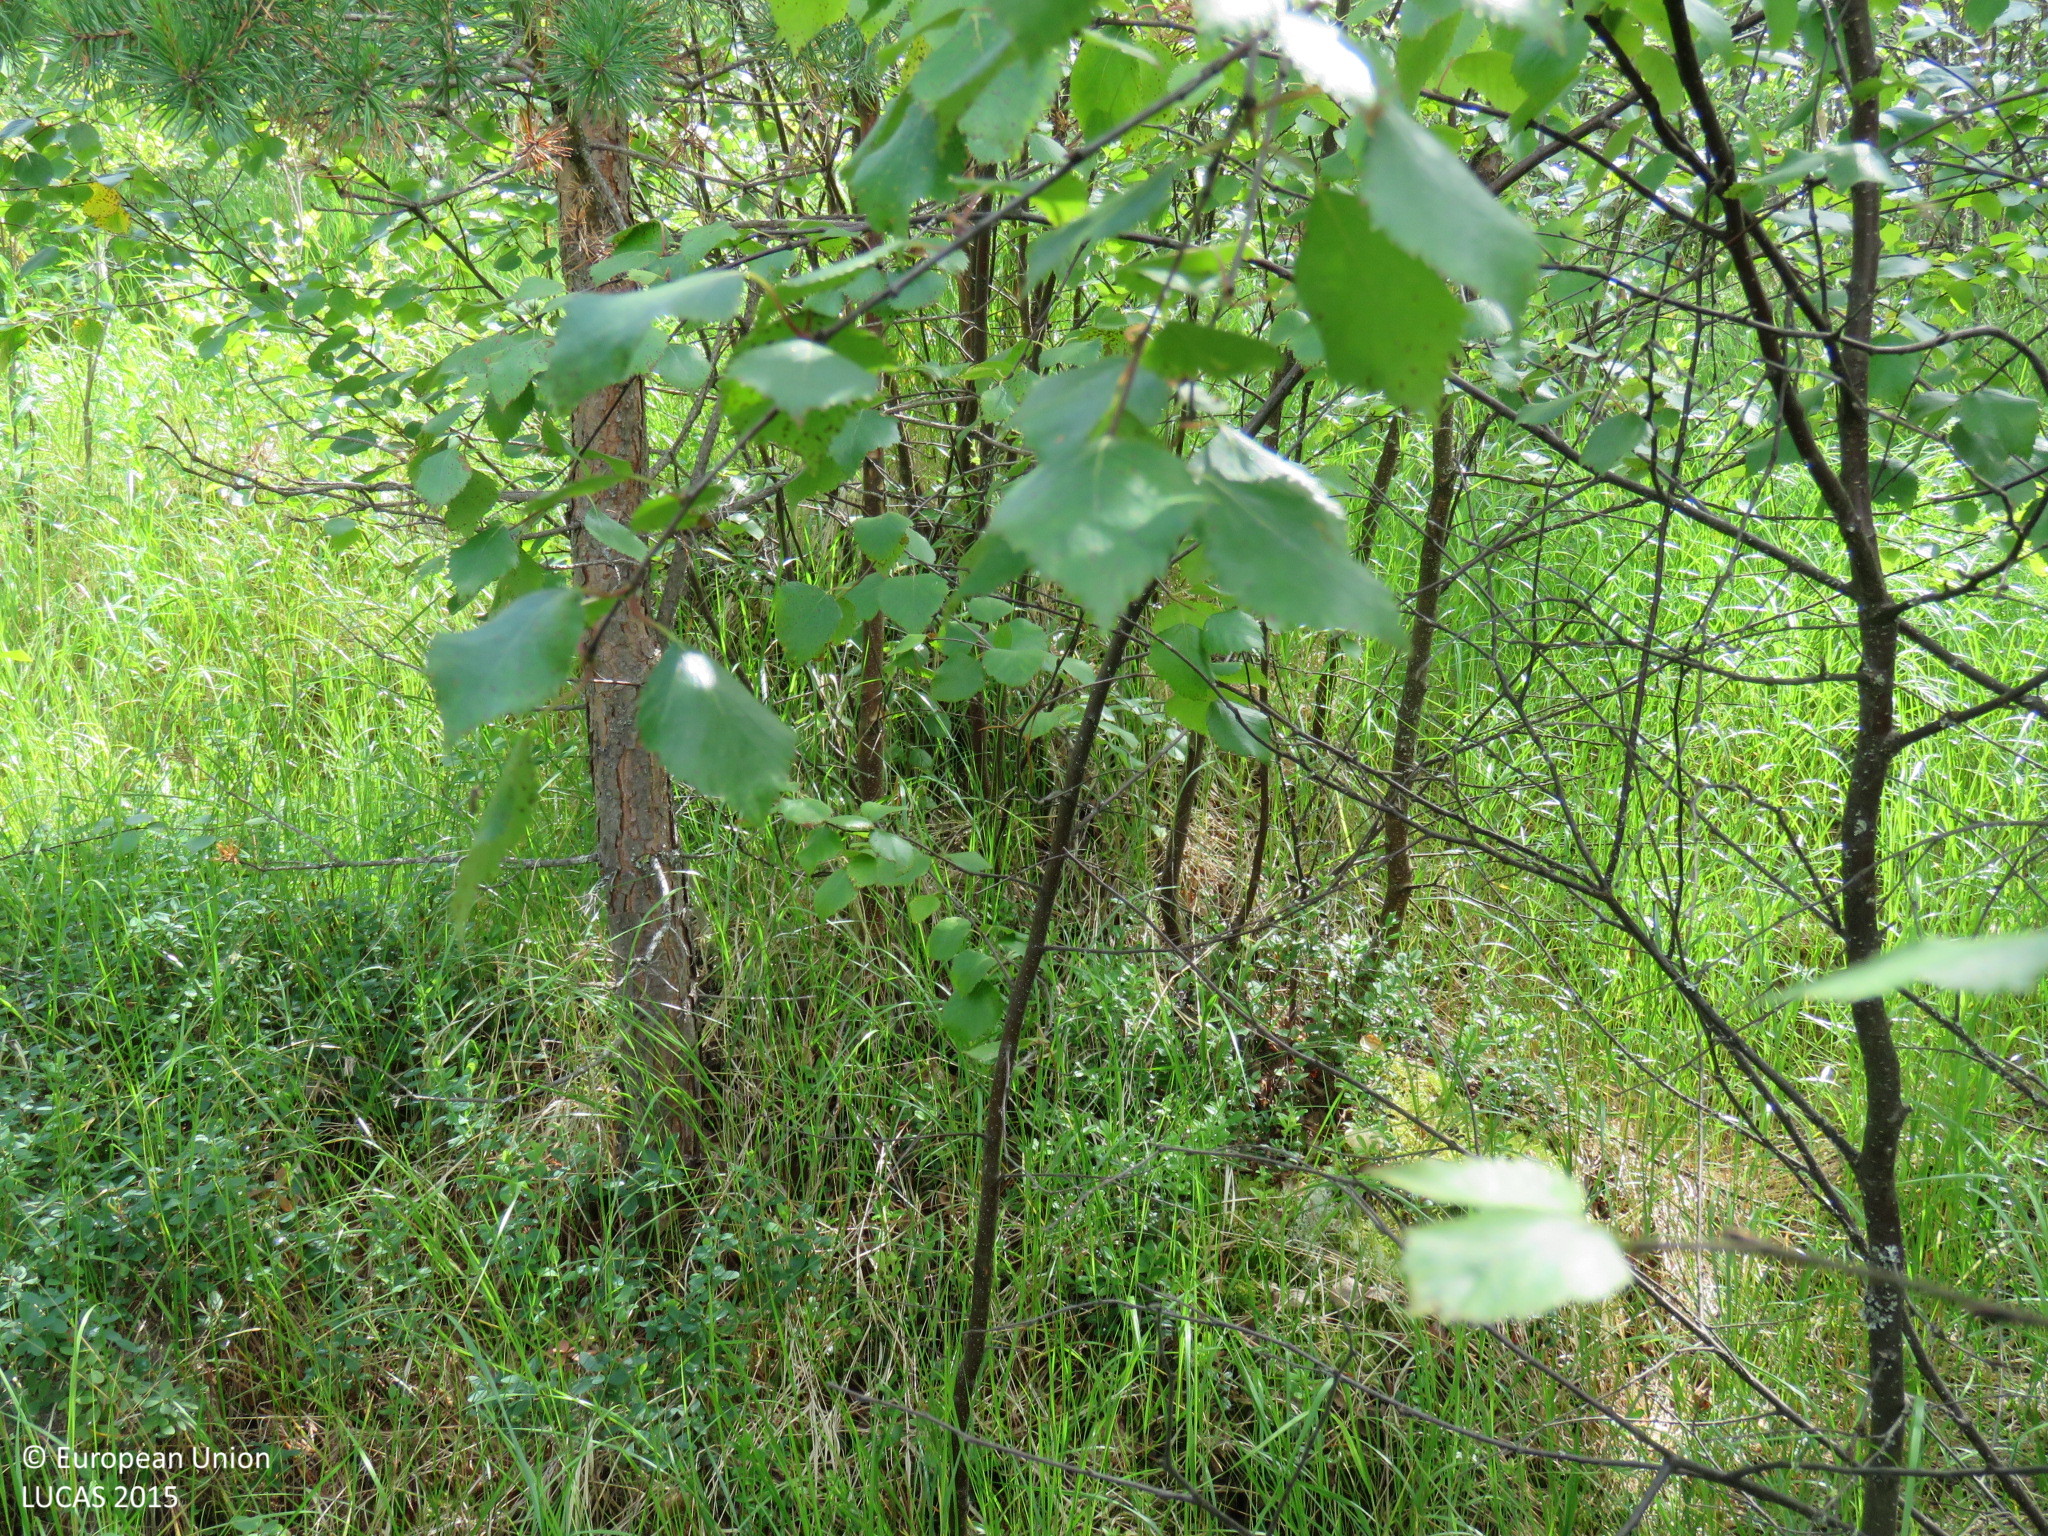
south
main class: Woodland
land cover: Pine dominated mixed woodland
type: boreal forest
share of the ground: > 75 %
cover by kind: broadleaved forest trees 50 %, coniferous forest trees 45 %, shrubs 5 %
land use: Forestry
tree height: < 5 m
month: July
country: FI
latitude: 64.6384
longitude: 26.4964
